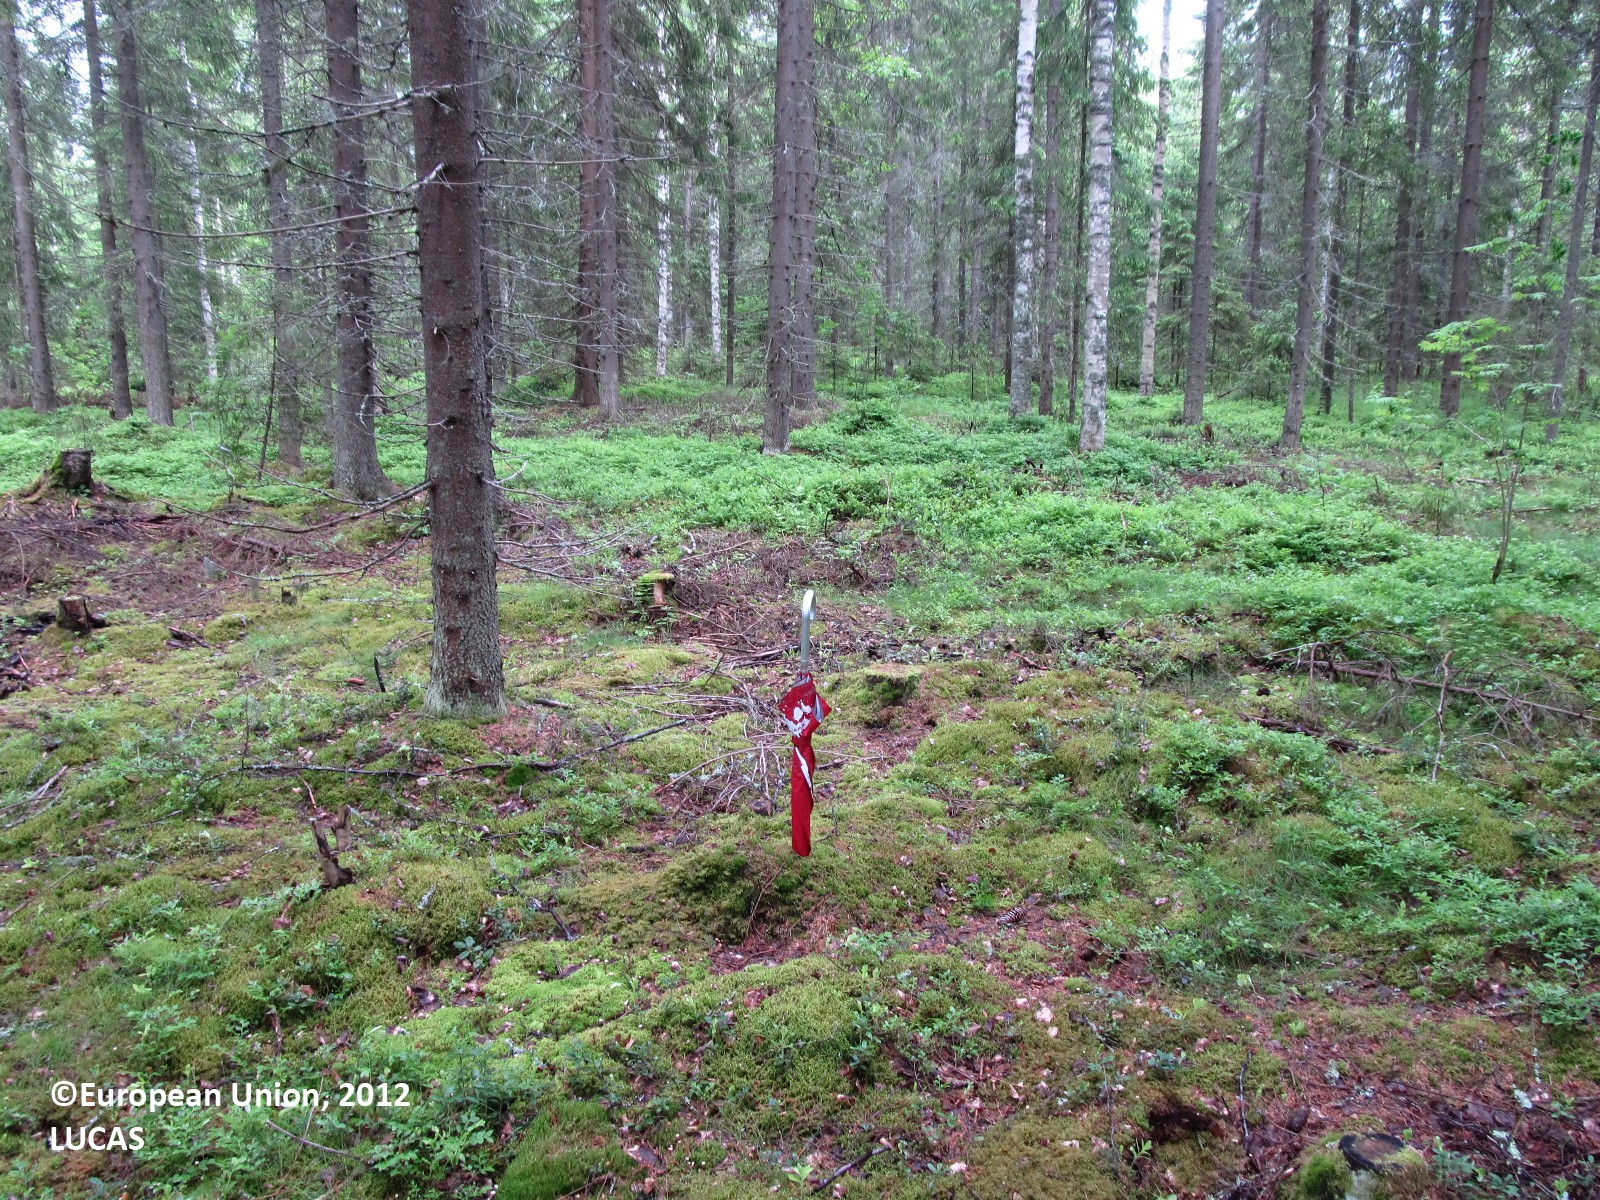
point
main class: Woodland
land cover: Spruce dominated coniferous woodland
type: boreal forest
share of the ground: 25 - 50 %
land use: Forestry
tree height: > 5 m
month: June
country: FI
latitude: 62.9249
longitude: 28.1643
